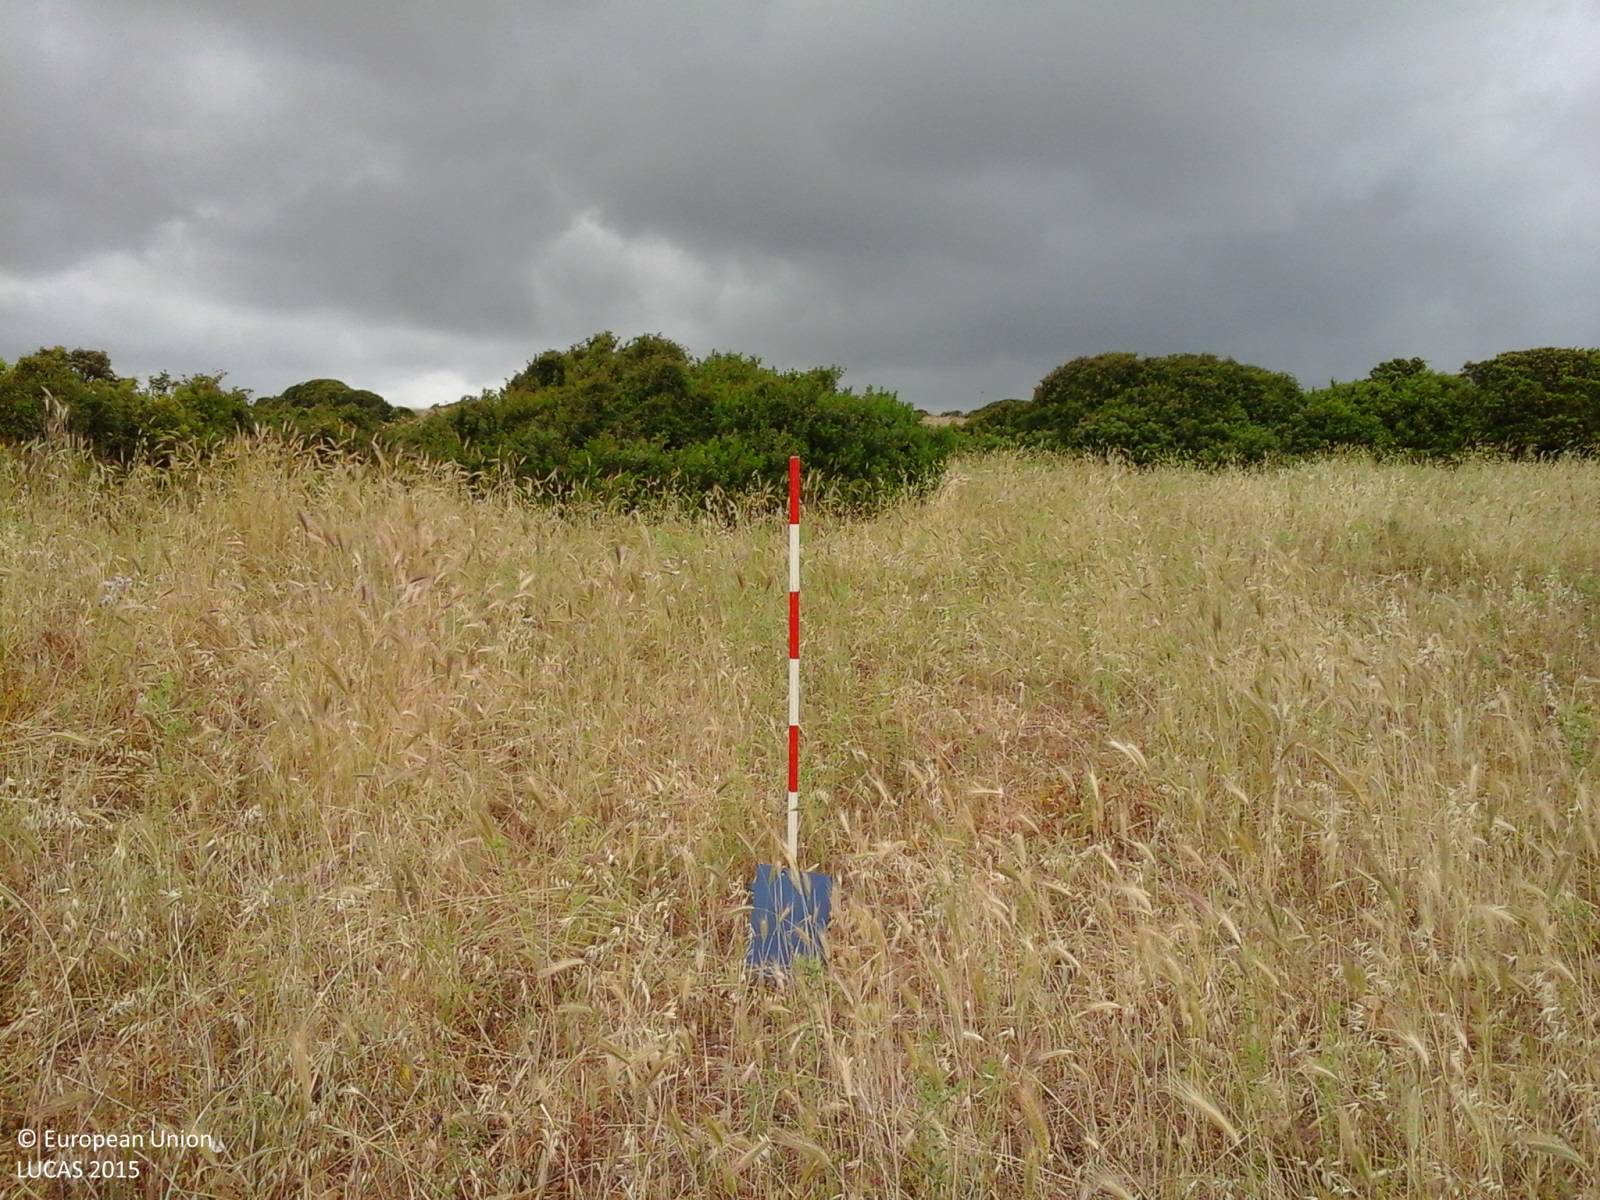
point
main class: Grassland
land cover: Spontaneously vegetated surfaces
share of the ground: > 75 %
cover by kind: herbaceous plants 100 %
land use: Agriculture (excluding fallow land and kitchen gardens)
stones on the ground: 25 - 50 %
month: May
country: IT
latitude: 39.8625
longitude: 8.8724
